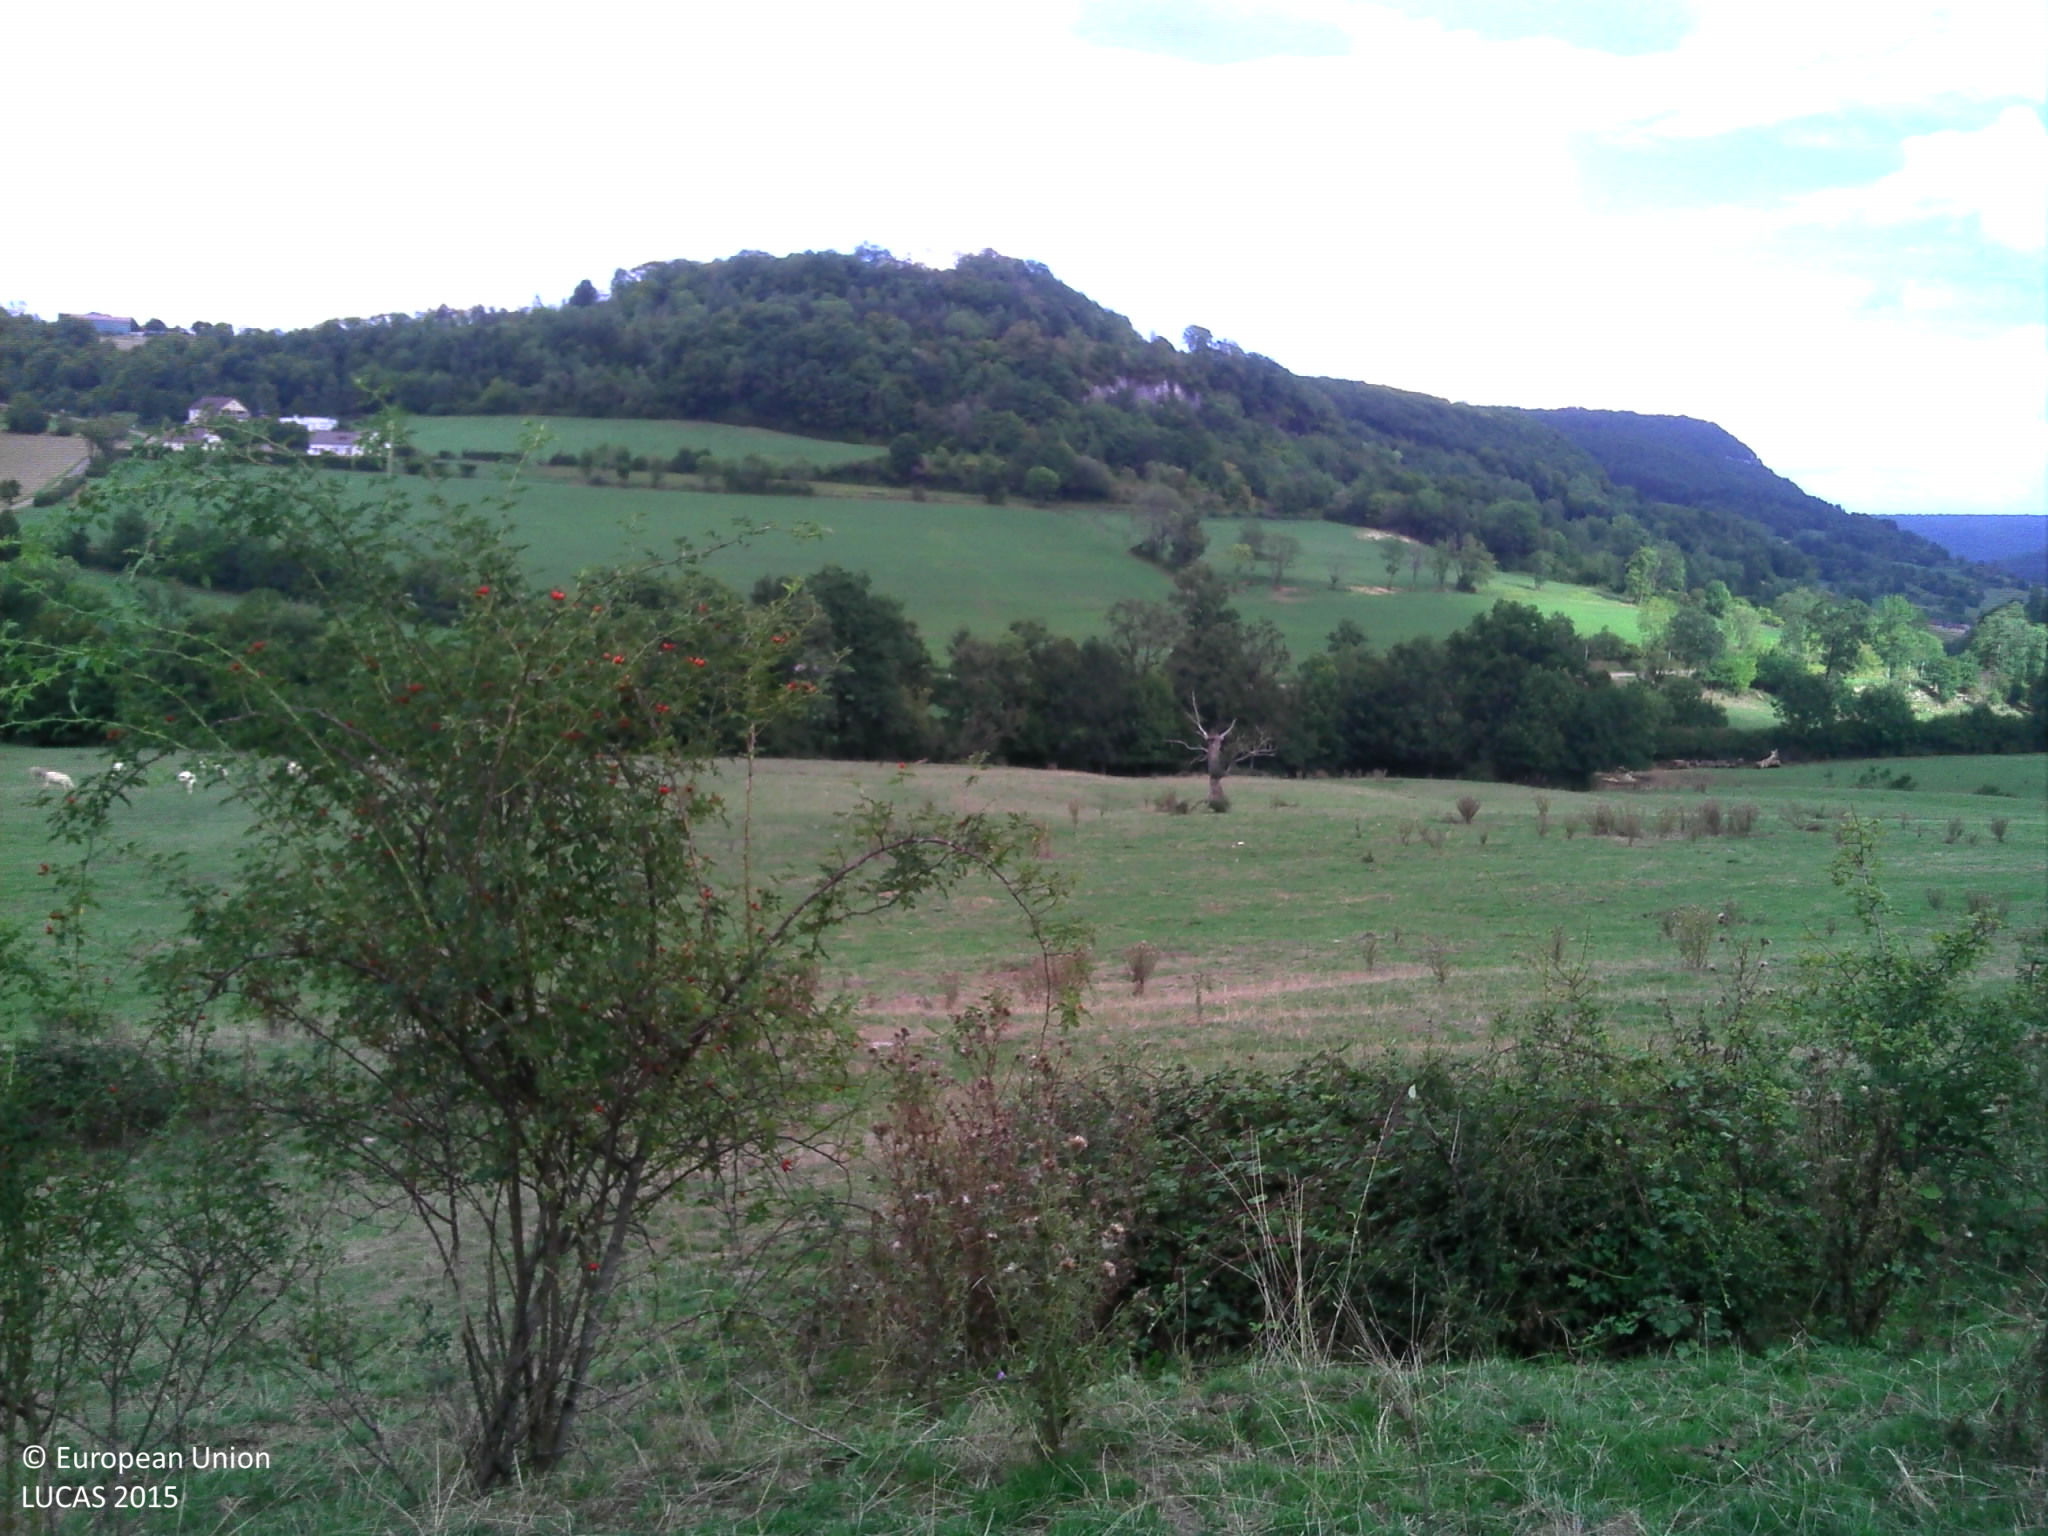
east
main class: Grassland
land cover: Grassland without tree/shrub cover
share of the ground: > 75 %
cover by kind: herbaceous plants 100 %
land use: Agriculture (excluding fallow land and kitchen gardens)
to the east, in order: Grassland without tree/shrub cover; Shrubland without tree cover; Grassland without tree/shrub cover; Grassland with sparse tree/shrub cover; Grassland without tree/shrub cover; Broadleaved woodland; Rivers and streams; Fences; Broadleaved woodland; Grassland without tree/shrub cover
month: August
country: FR
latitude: 47.2664
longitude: 4.7000
